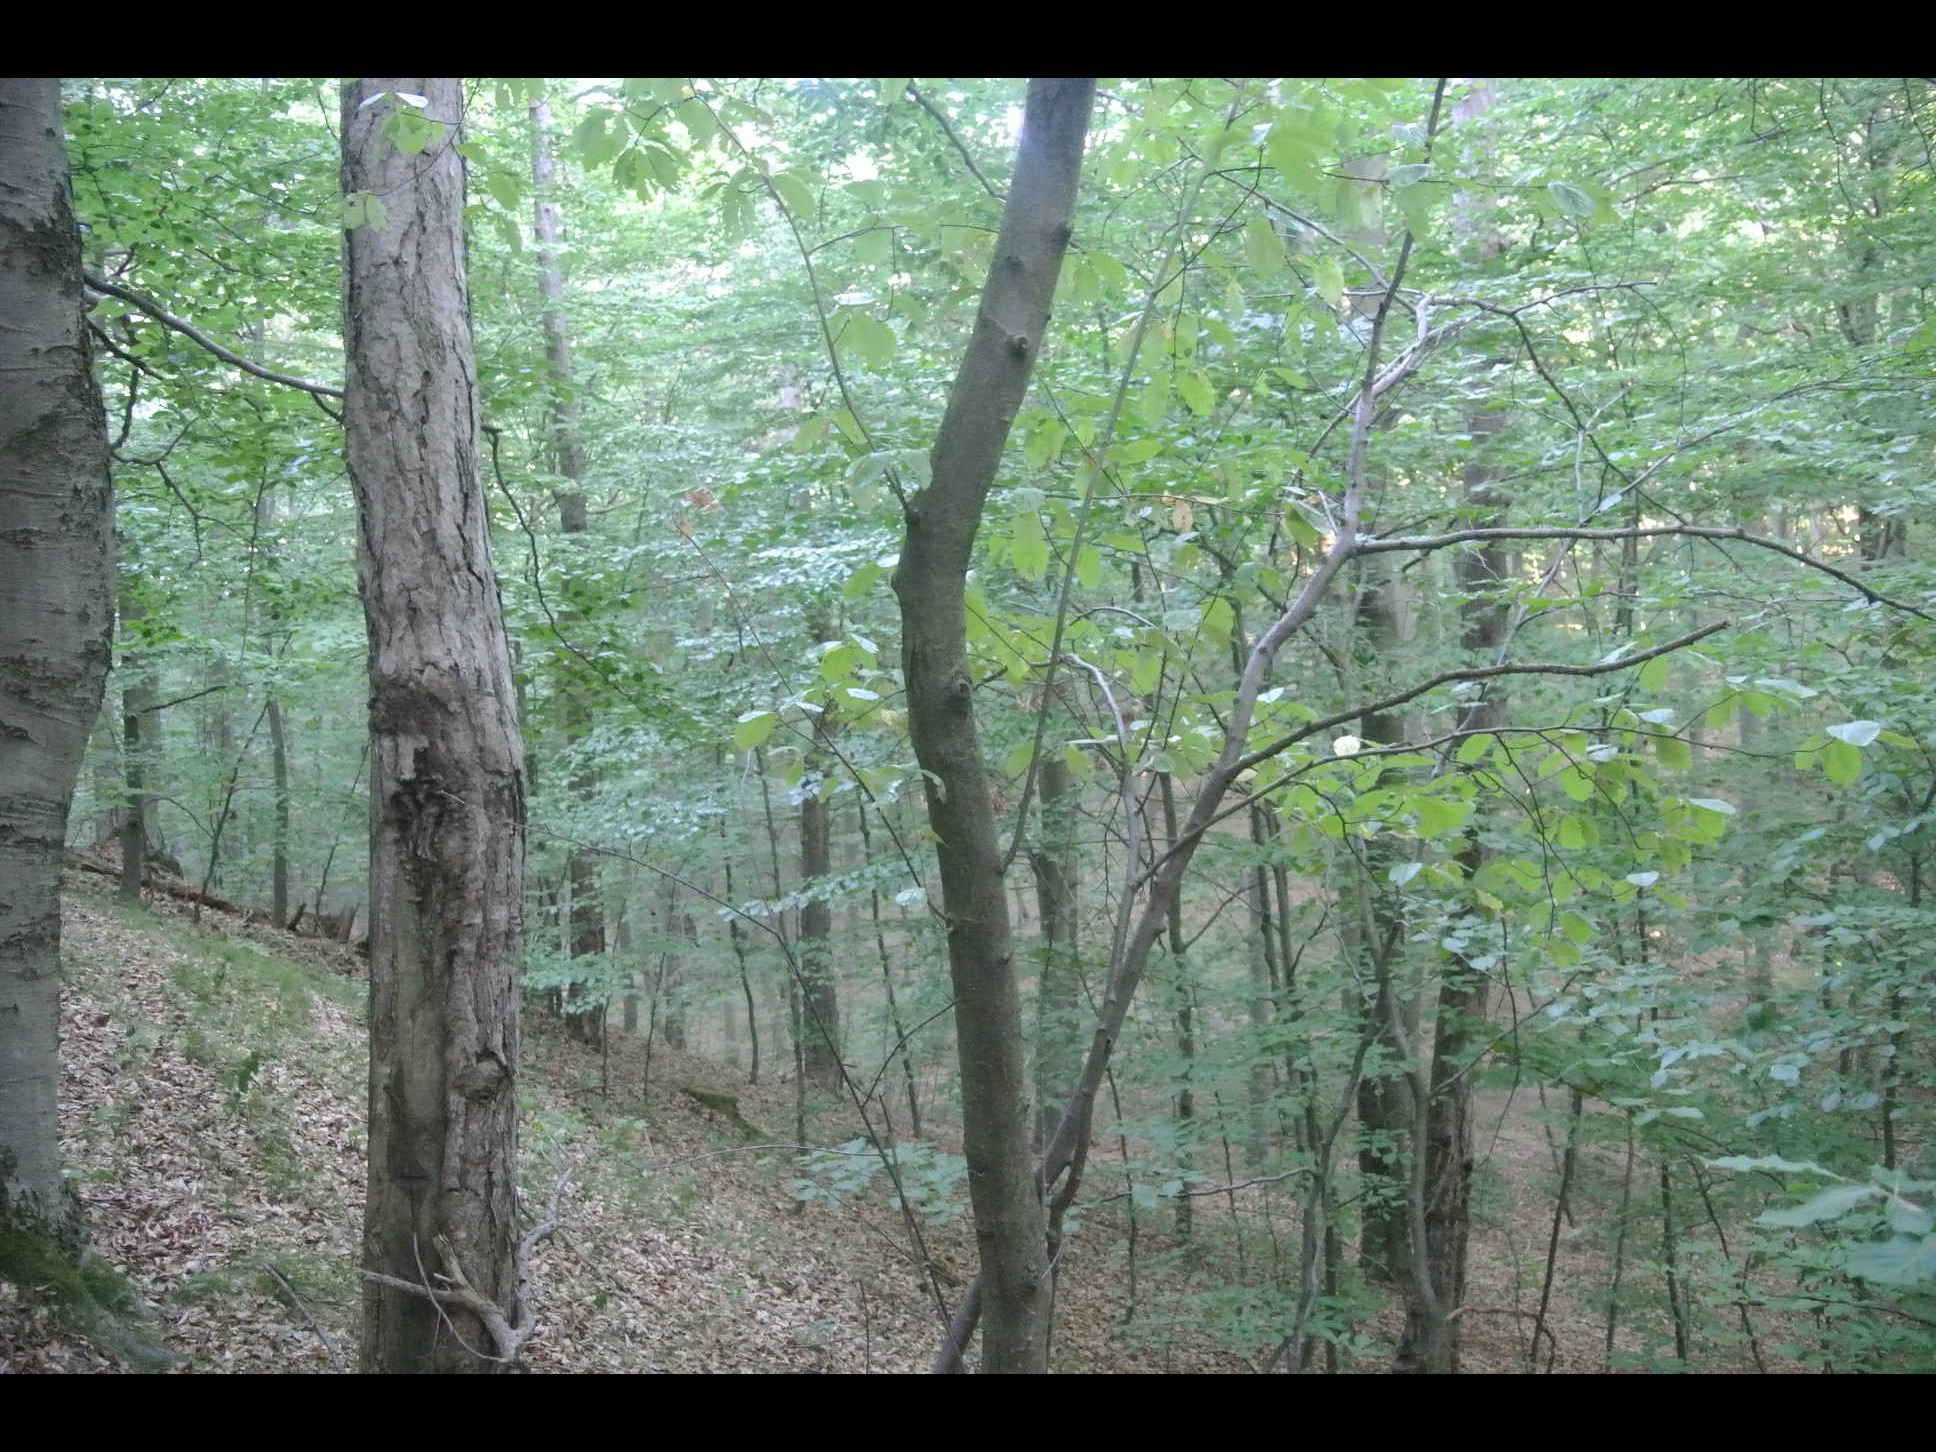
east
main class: Woodland
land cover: Pine dominated mixed woodland
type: beech forest
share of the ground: > 75 %
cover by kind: broadleaved forest trees 75 %, coniferous forest trees 25 %
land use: Forestry
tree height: > 5 m
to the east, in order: Pine dominated mixed woodland; Other coniferous woodland
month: July
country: AT
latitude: 47.9959
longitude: 16.1820
